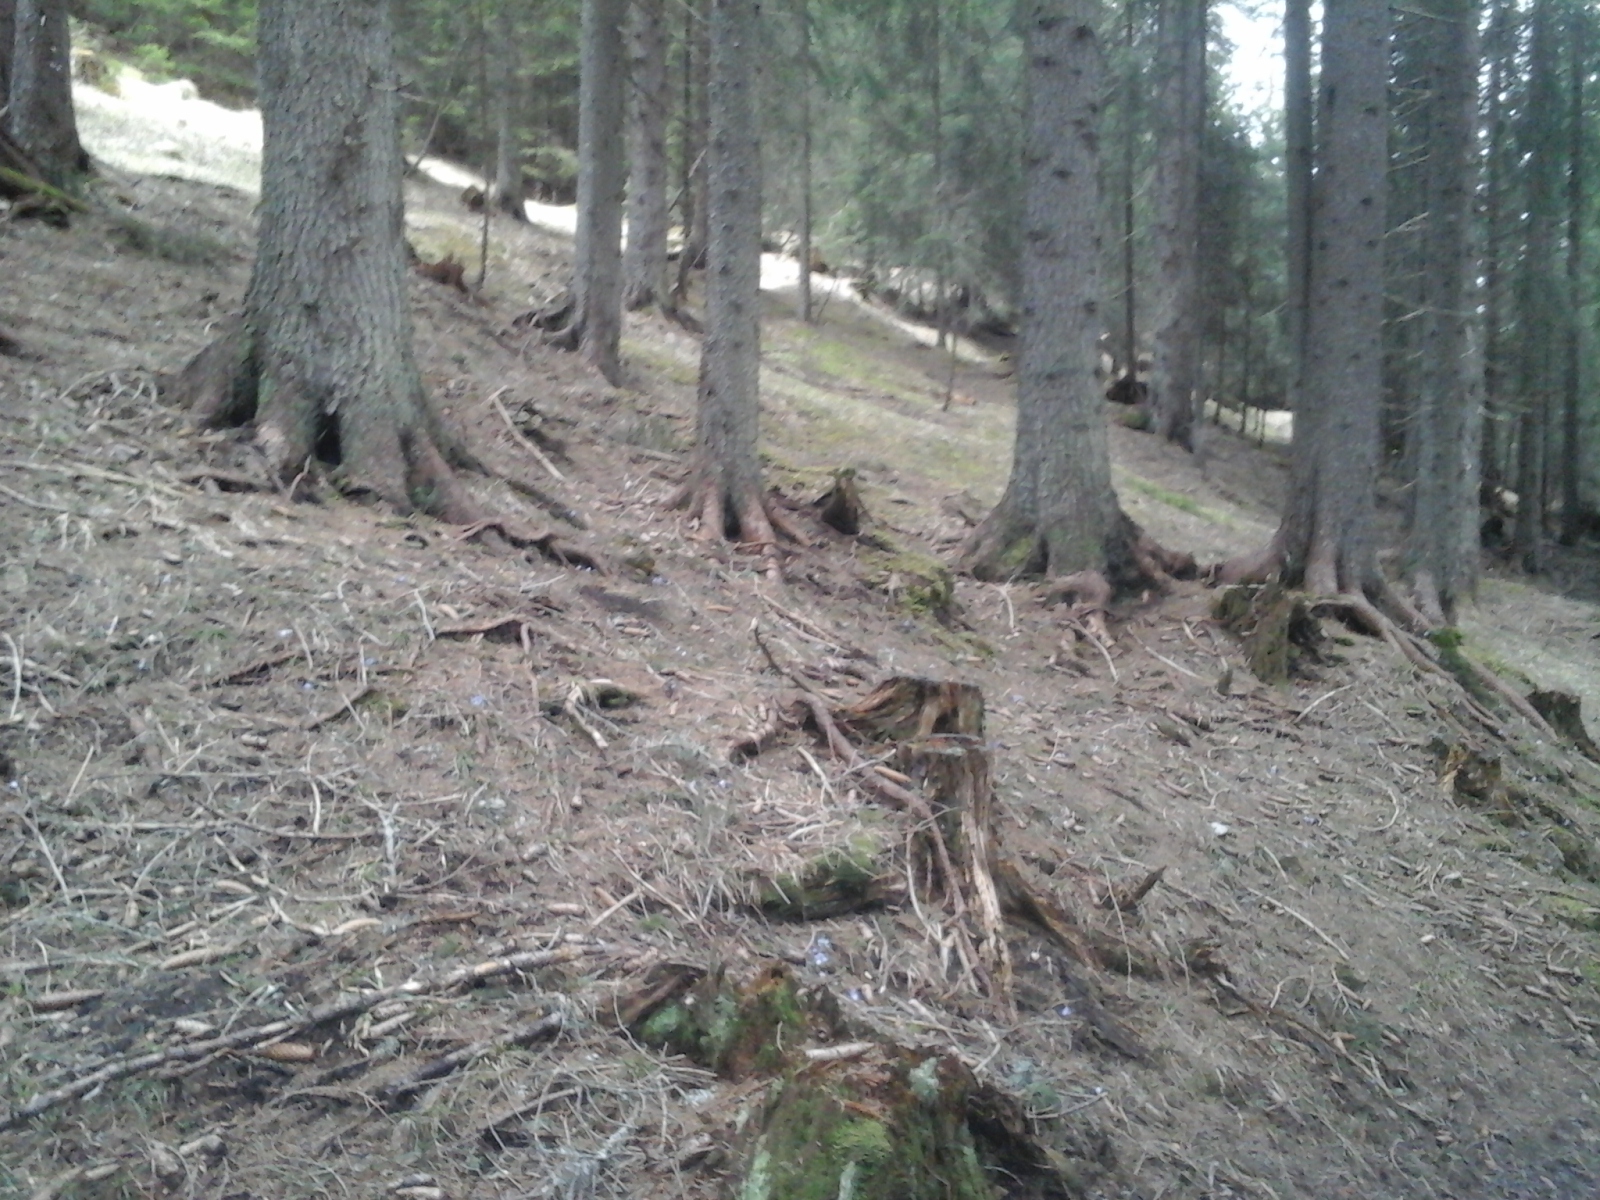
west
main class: Woodland
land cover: Spruce dominated coniferous woodland
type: alpine coniferous forest
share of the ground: > 75 %
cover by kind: coniferous forest trees 95 %, herbaceous plants 5 %
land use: Forestry
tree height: > 5 m
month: May
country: IT
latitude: 46.3929
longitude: 11.6236
